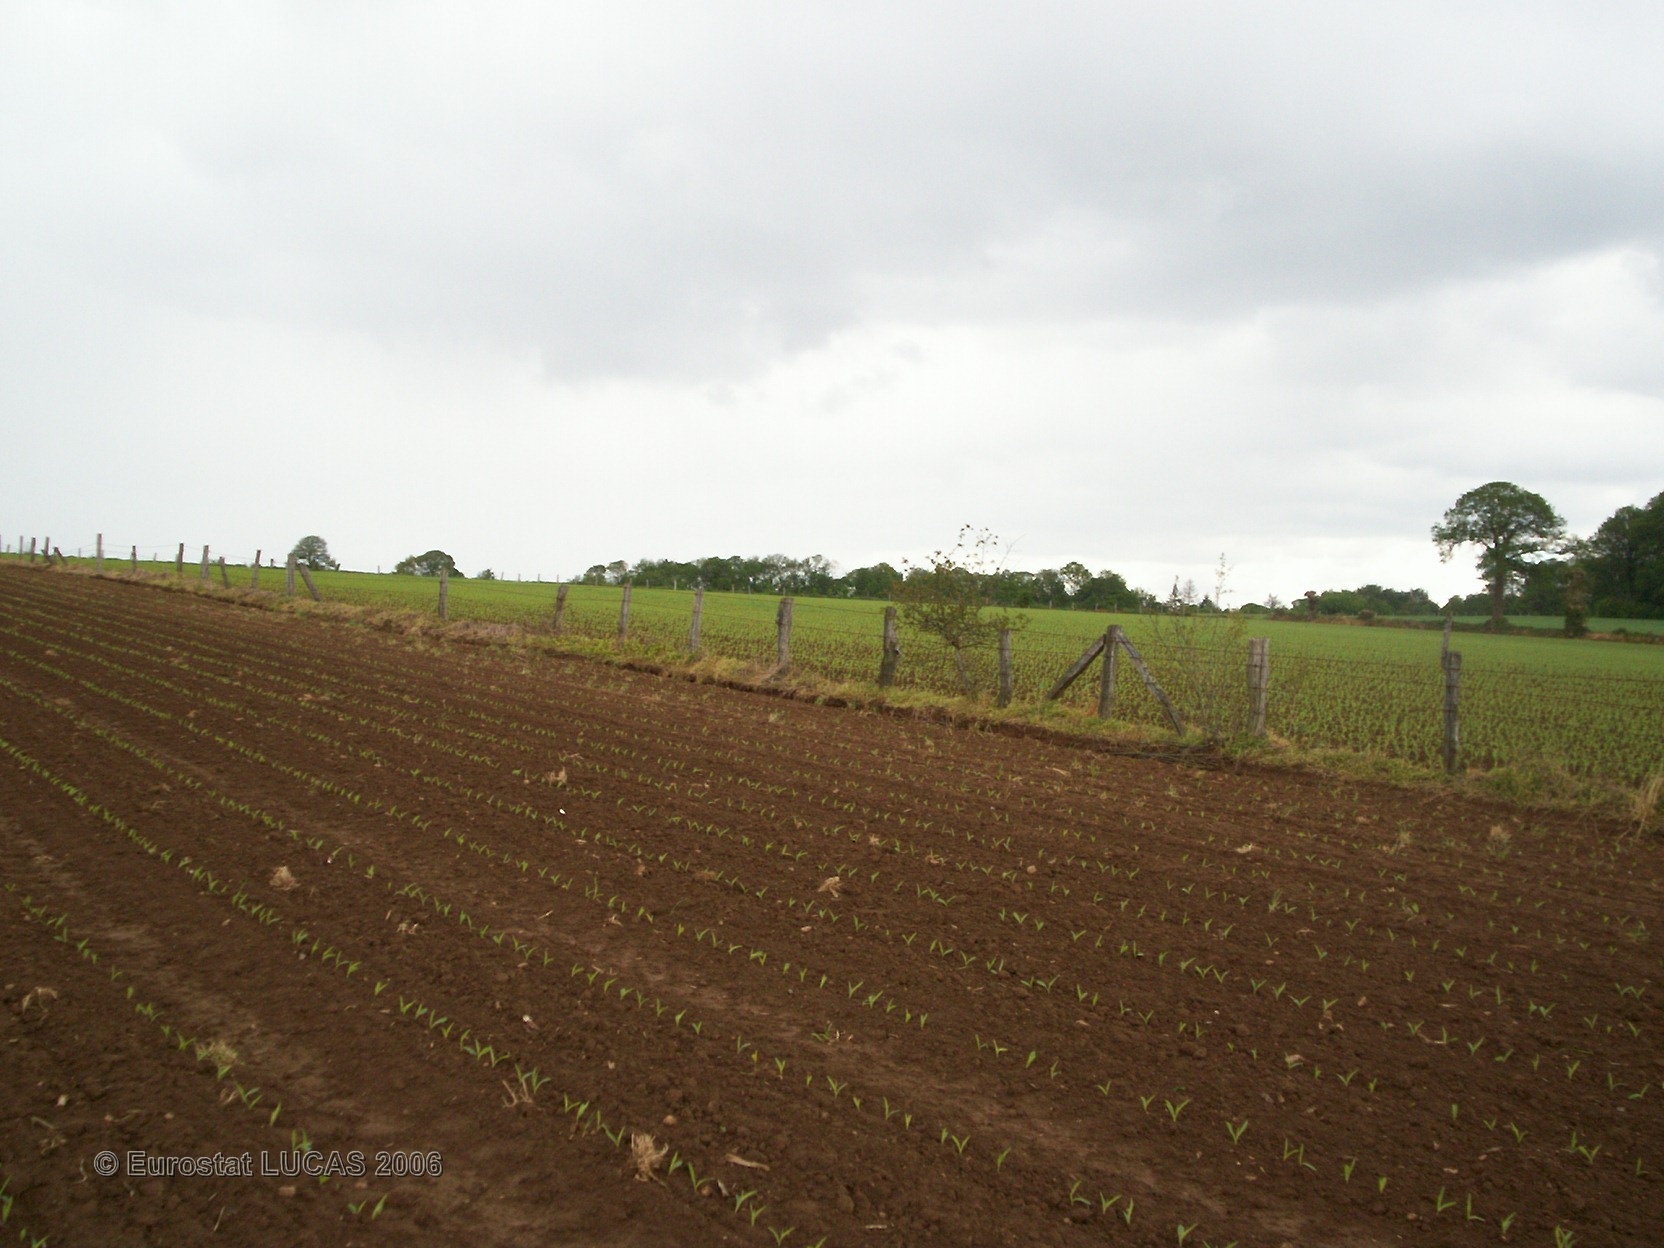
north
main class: Cropland
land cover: Maize
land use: Agriculture (excluding fallow land and kitchen gardens)
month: May
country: FR
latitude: 48.4805
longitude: -0.7112
